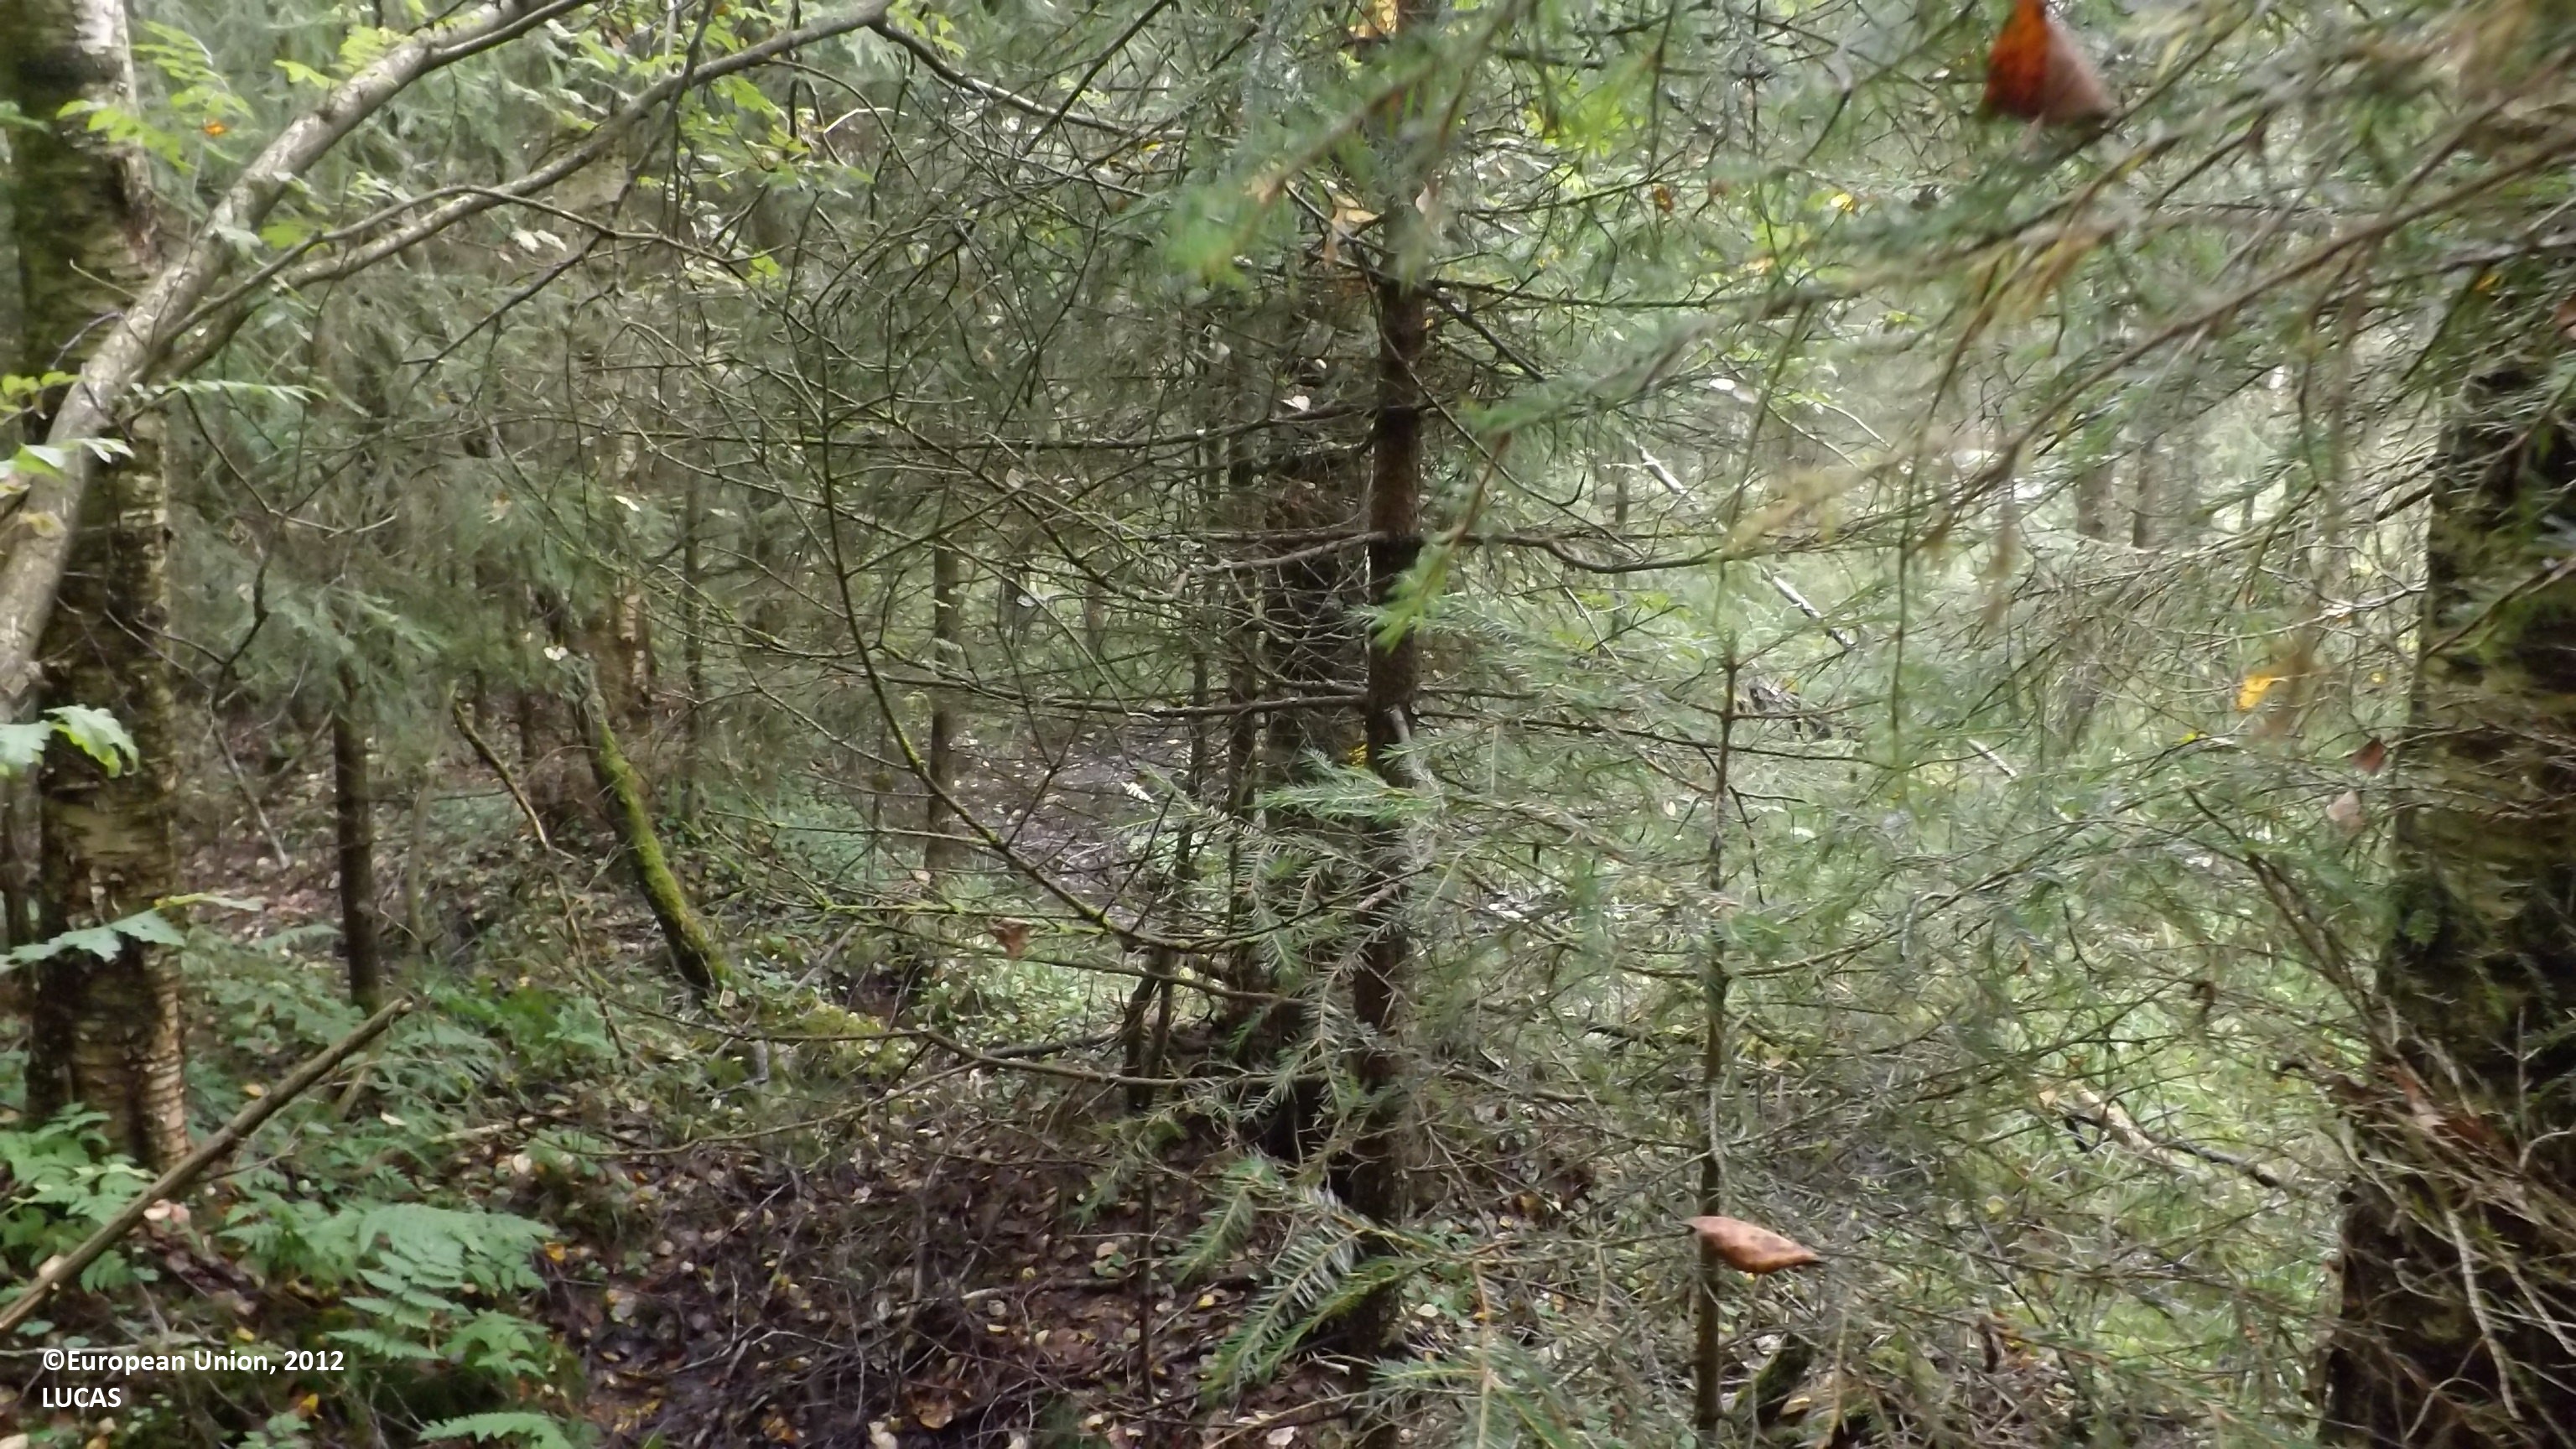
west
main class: Woodland
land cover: Spruce dominated mixed woodland
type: boreal forest
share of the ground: > 75 %
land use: Forestry
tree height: > 5 m
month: August
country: FI
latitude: 63.8437
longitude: 23.4156
